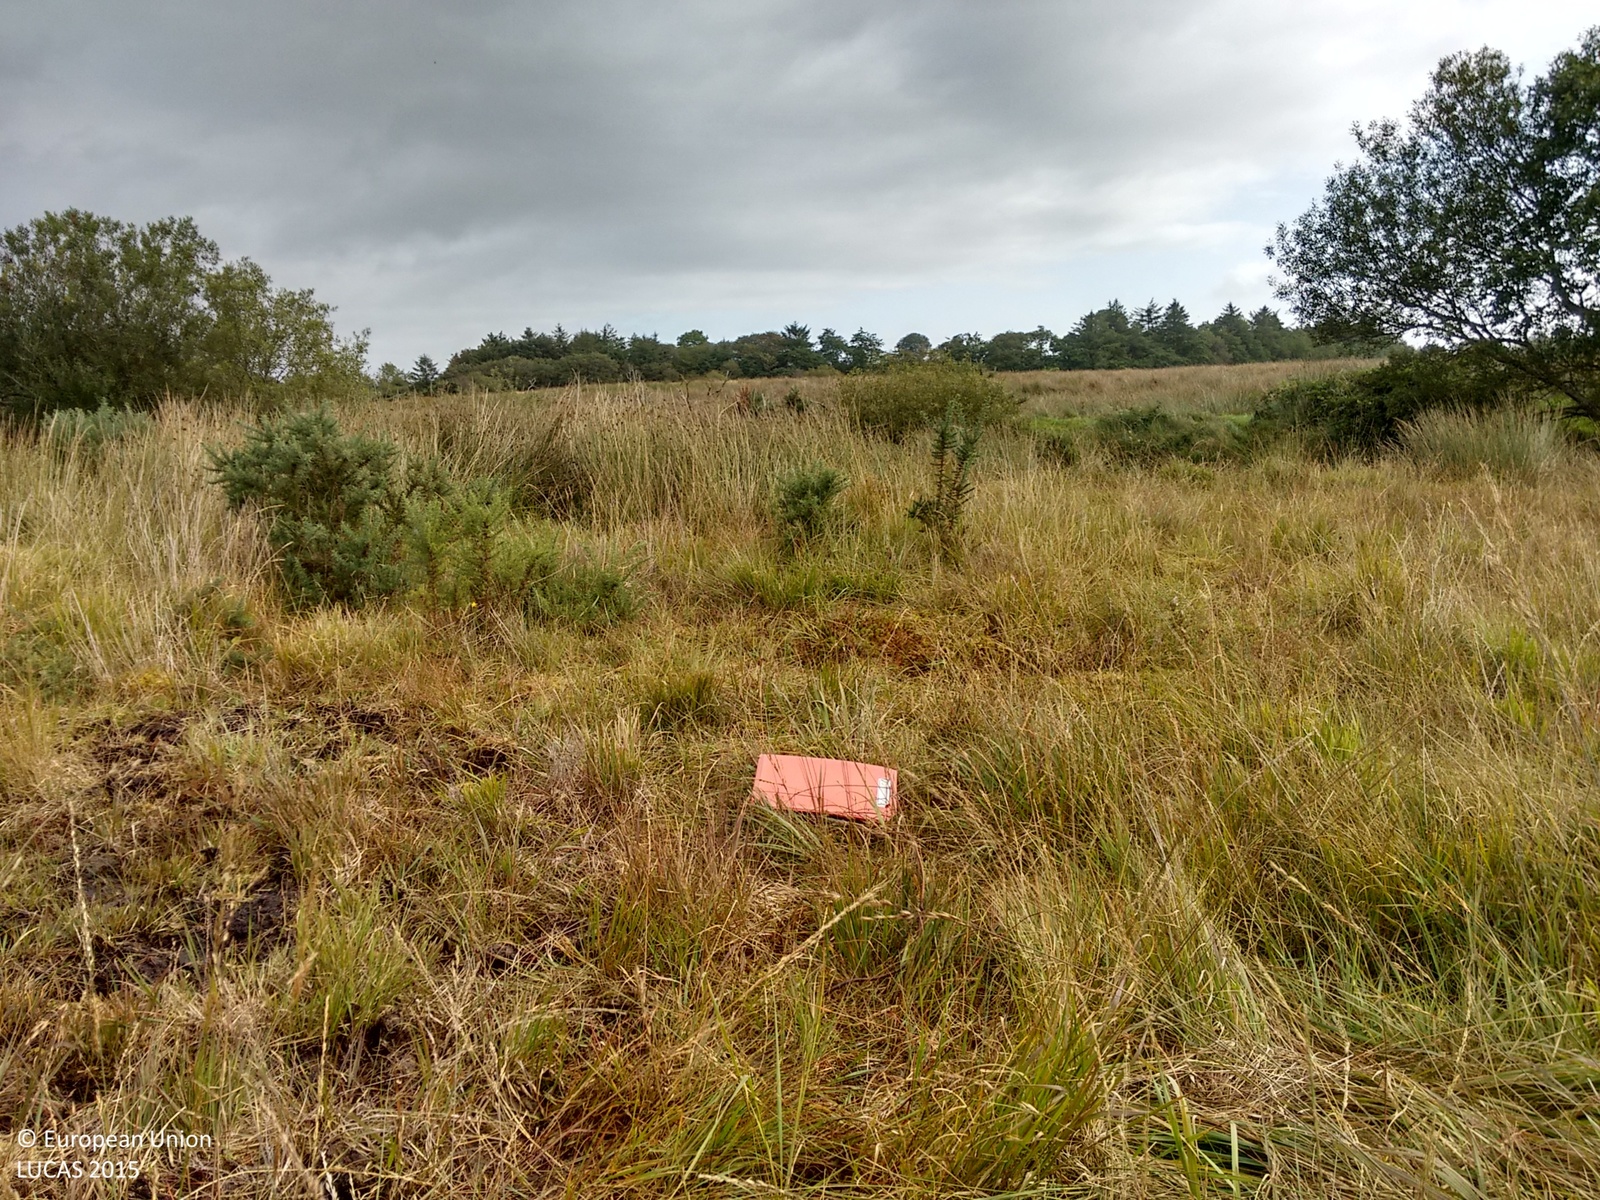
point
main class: Grassland
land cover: Grassland with sparse tree/shrub cover
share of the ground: > 75 %
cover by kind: herbaceous plants 85 %, shrubs 10 %, broadleaved forest trees 5 %
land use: Agriculture (excluding fallow land and kitchen gardens)
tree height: < 5 m
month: September
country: IE
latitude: 53.7603
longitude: -8.9114
